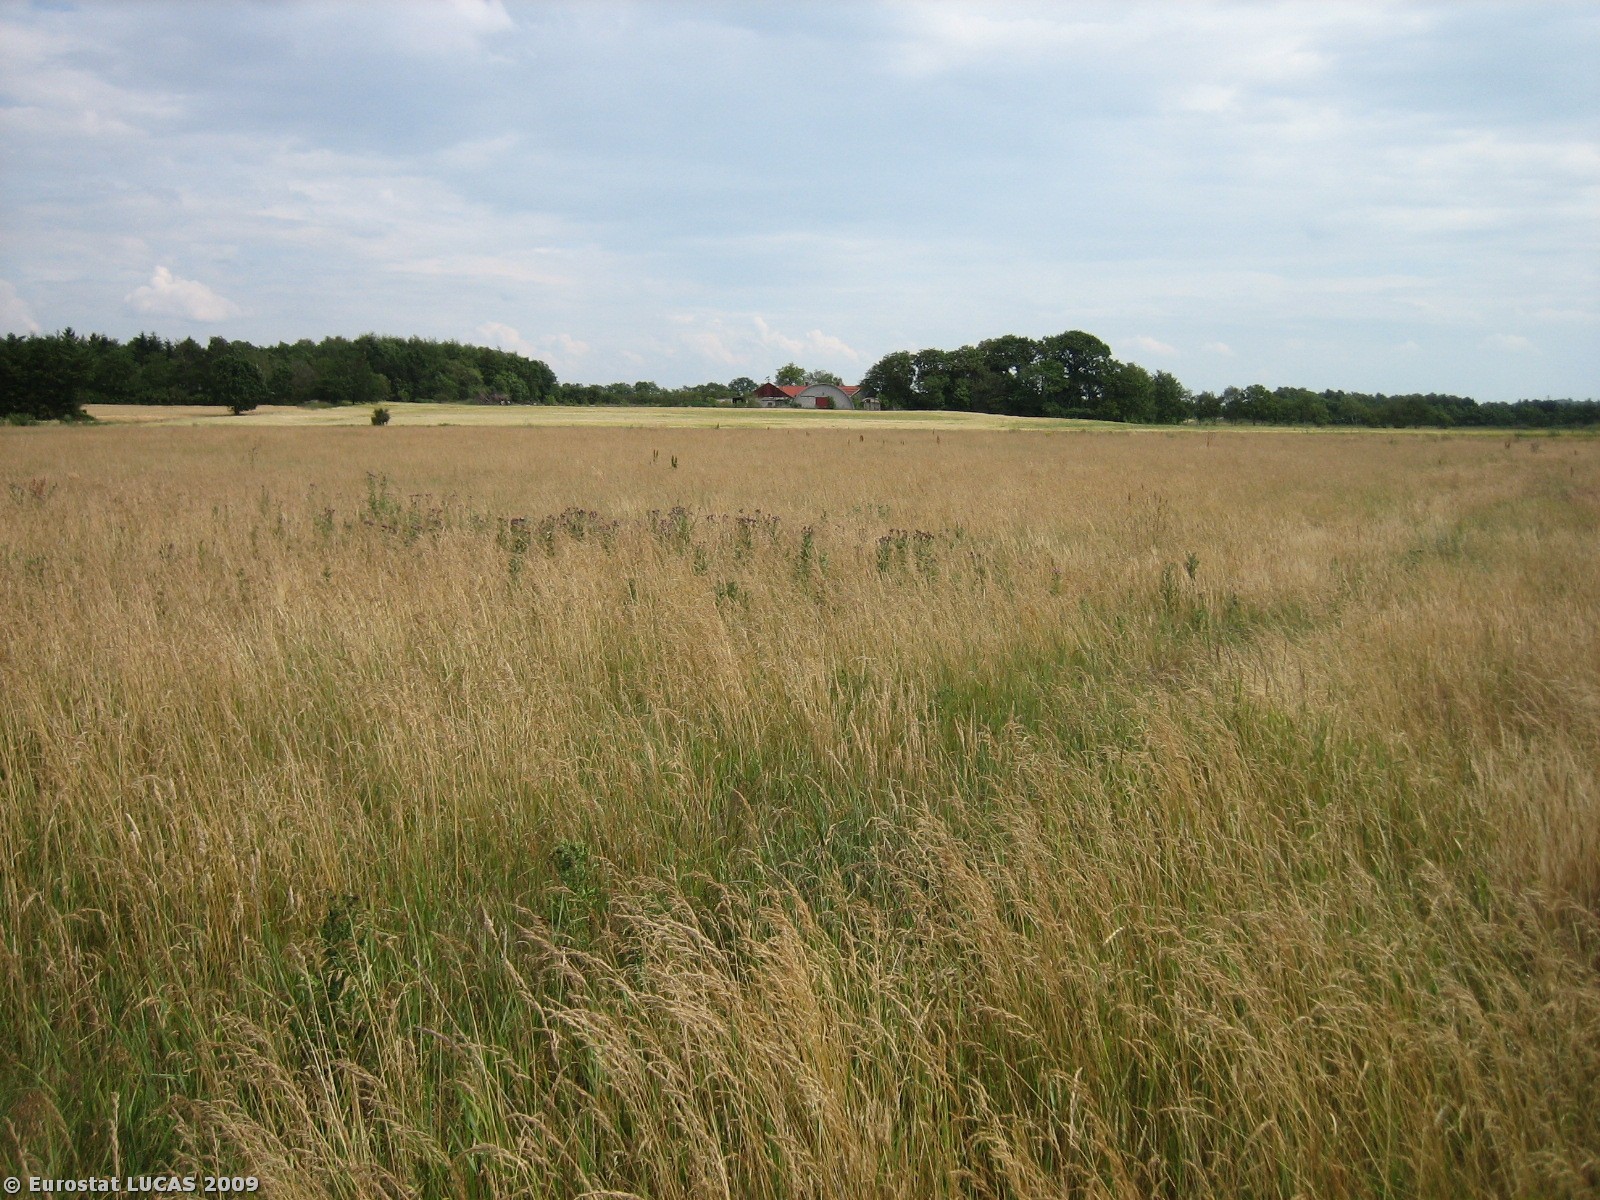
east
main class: Grassland
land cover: Grassland without tree/shrub cover
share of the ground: > 75 %
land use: Fallow land
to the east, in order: Grassland without tree/shrub cover; Ditches and canals; Grass margins; Barley
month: July
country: DK
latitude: 55.8945
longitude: 8.8019
